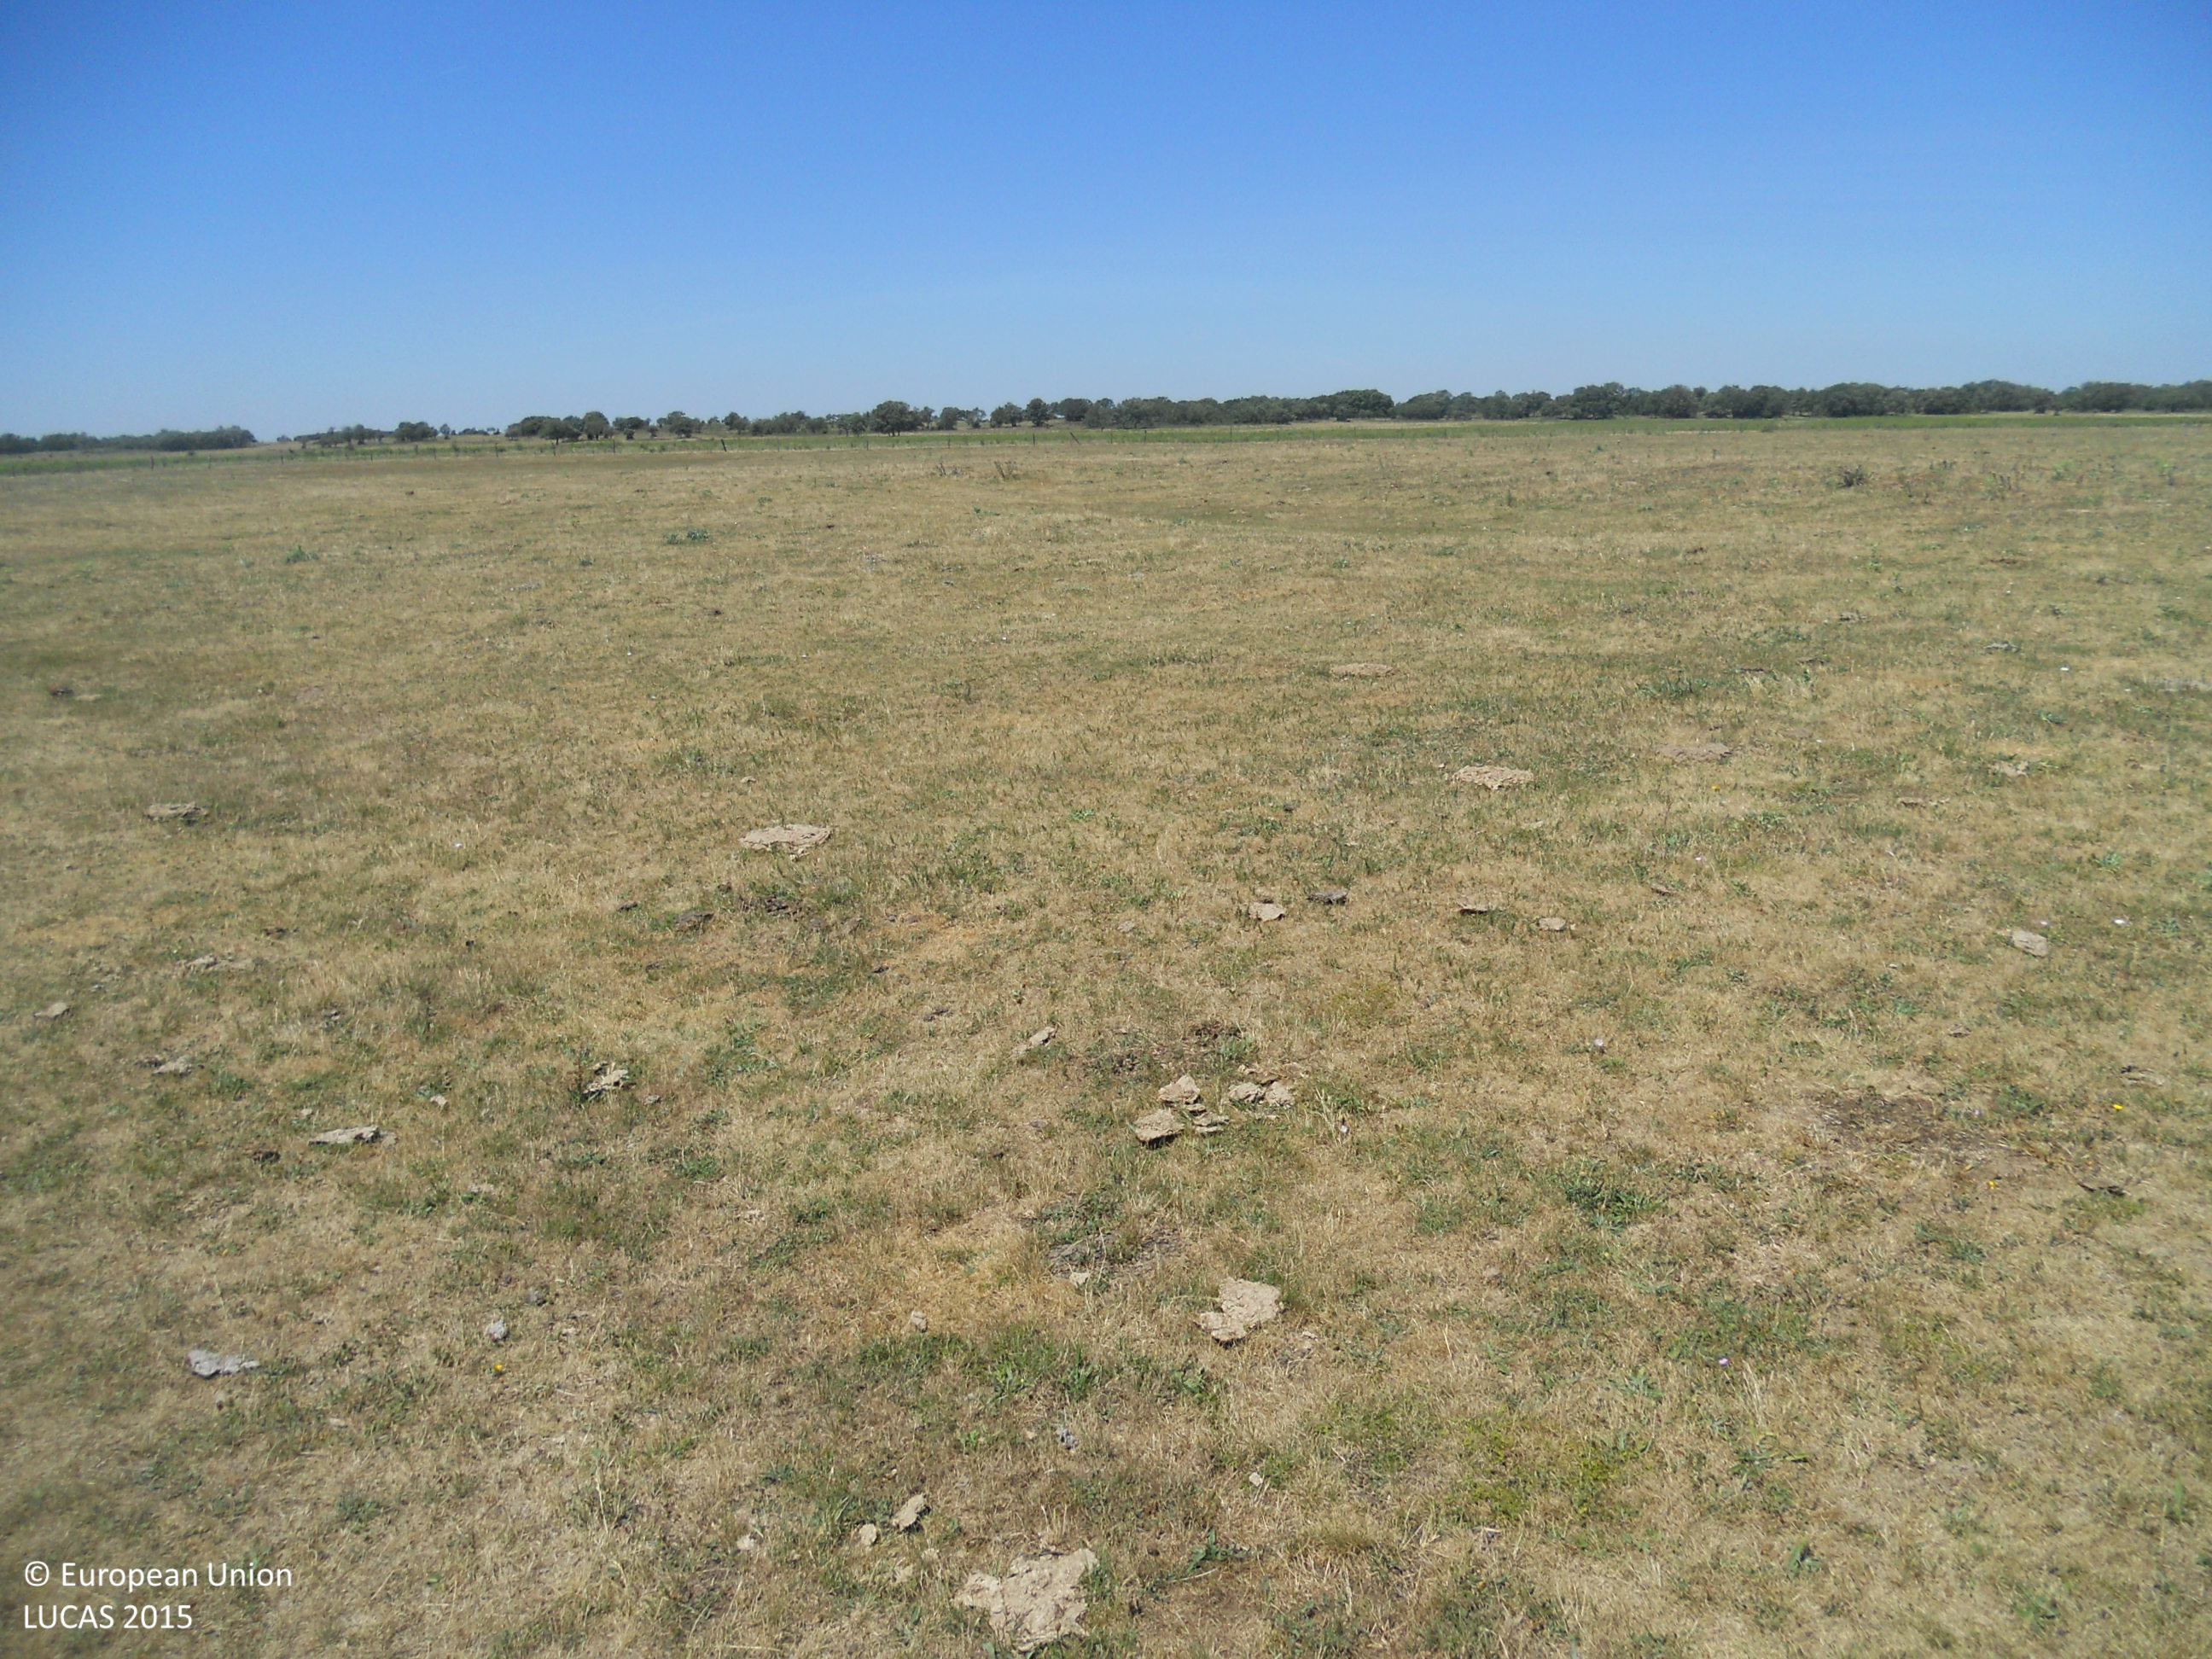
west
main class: Grassland
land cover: Grassland without tree/shrub cover
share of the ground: > 75 %
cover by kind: herbaceous plants 100 %
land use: Agriculture (excluding fallow land and kitchen gardens)
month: June
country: ES
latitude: 42.3687
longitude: -4.7843
